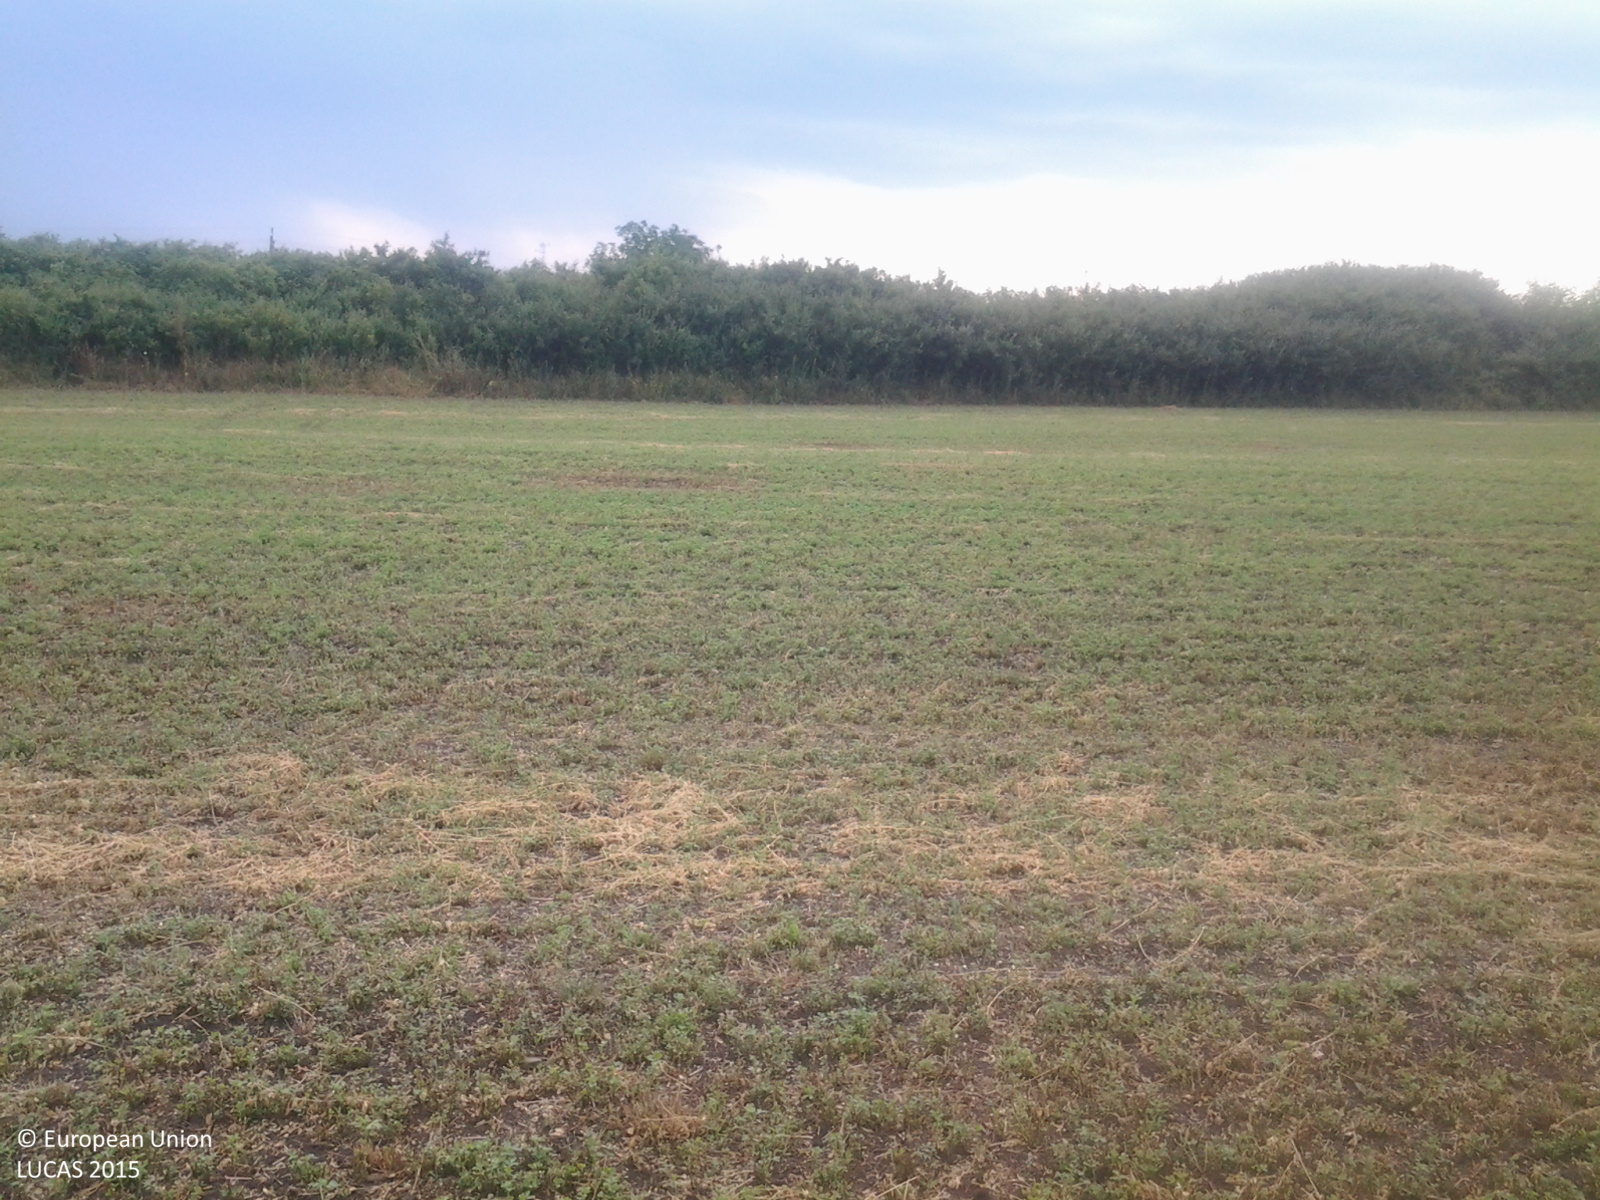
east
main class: Cropland
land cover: Lucerne
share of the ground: > 75 %
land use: Agriculture (excluding fallow land and kitchen gardens)
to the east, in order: Lucerne; Abandoned hedges; Artificial constructions; Inland fresh running water; Arable land (only in case pi)
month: August
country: HU
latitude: 46.9202
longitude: 21.2380
